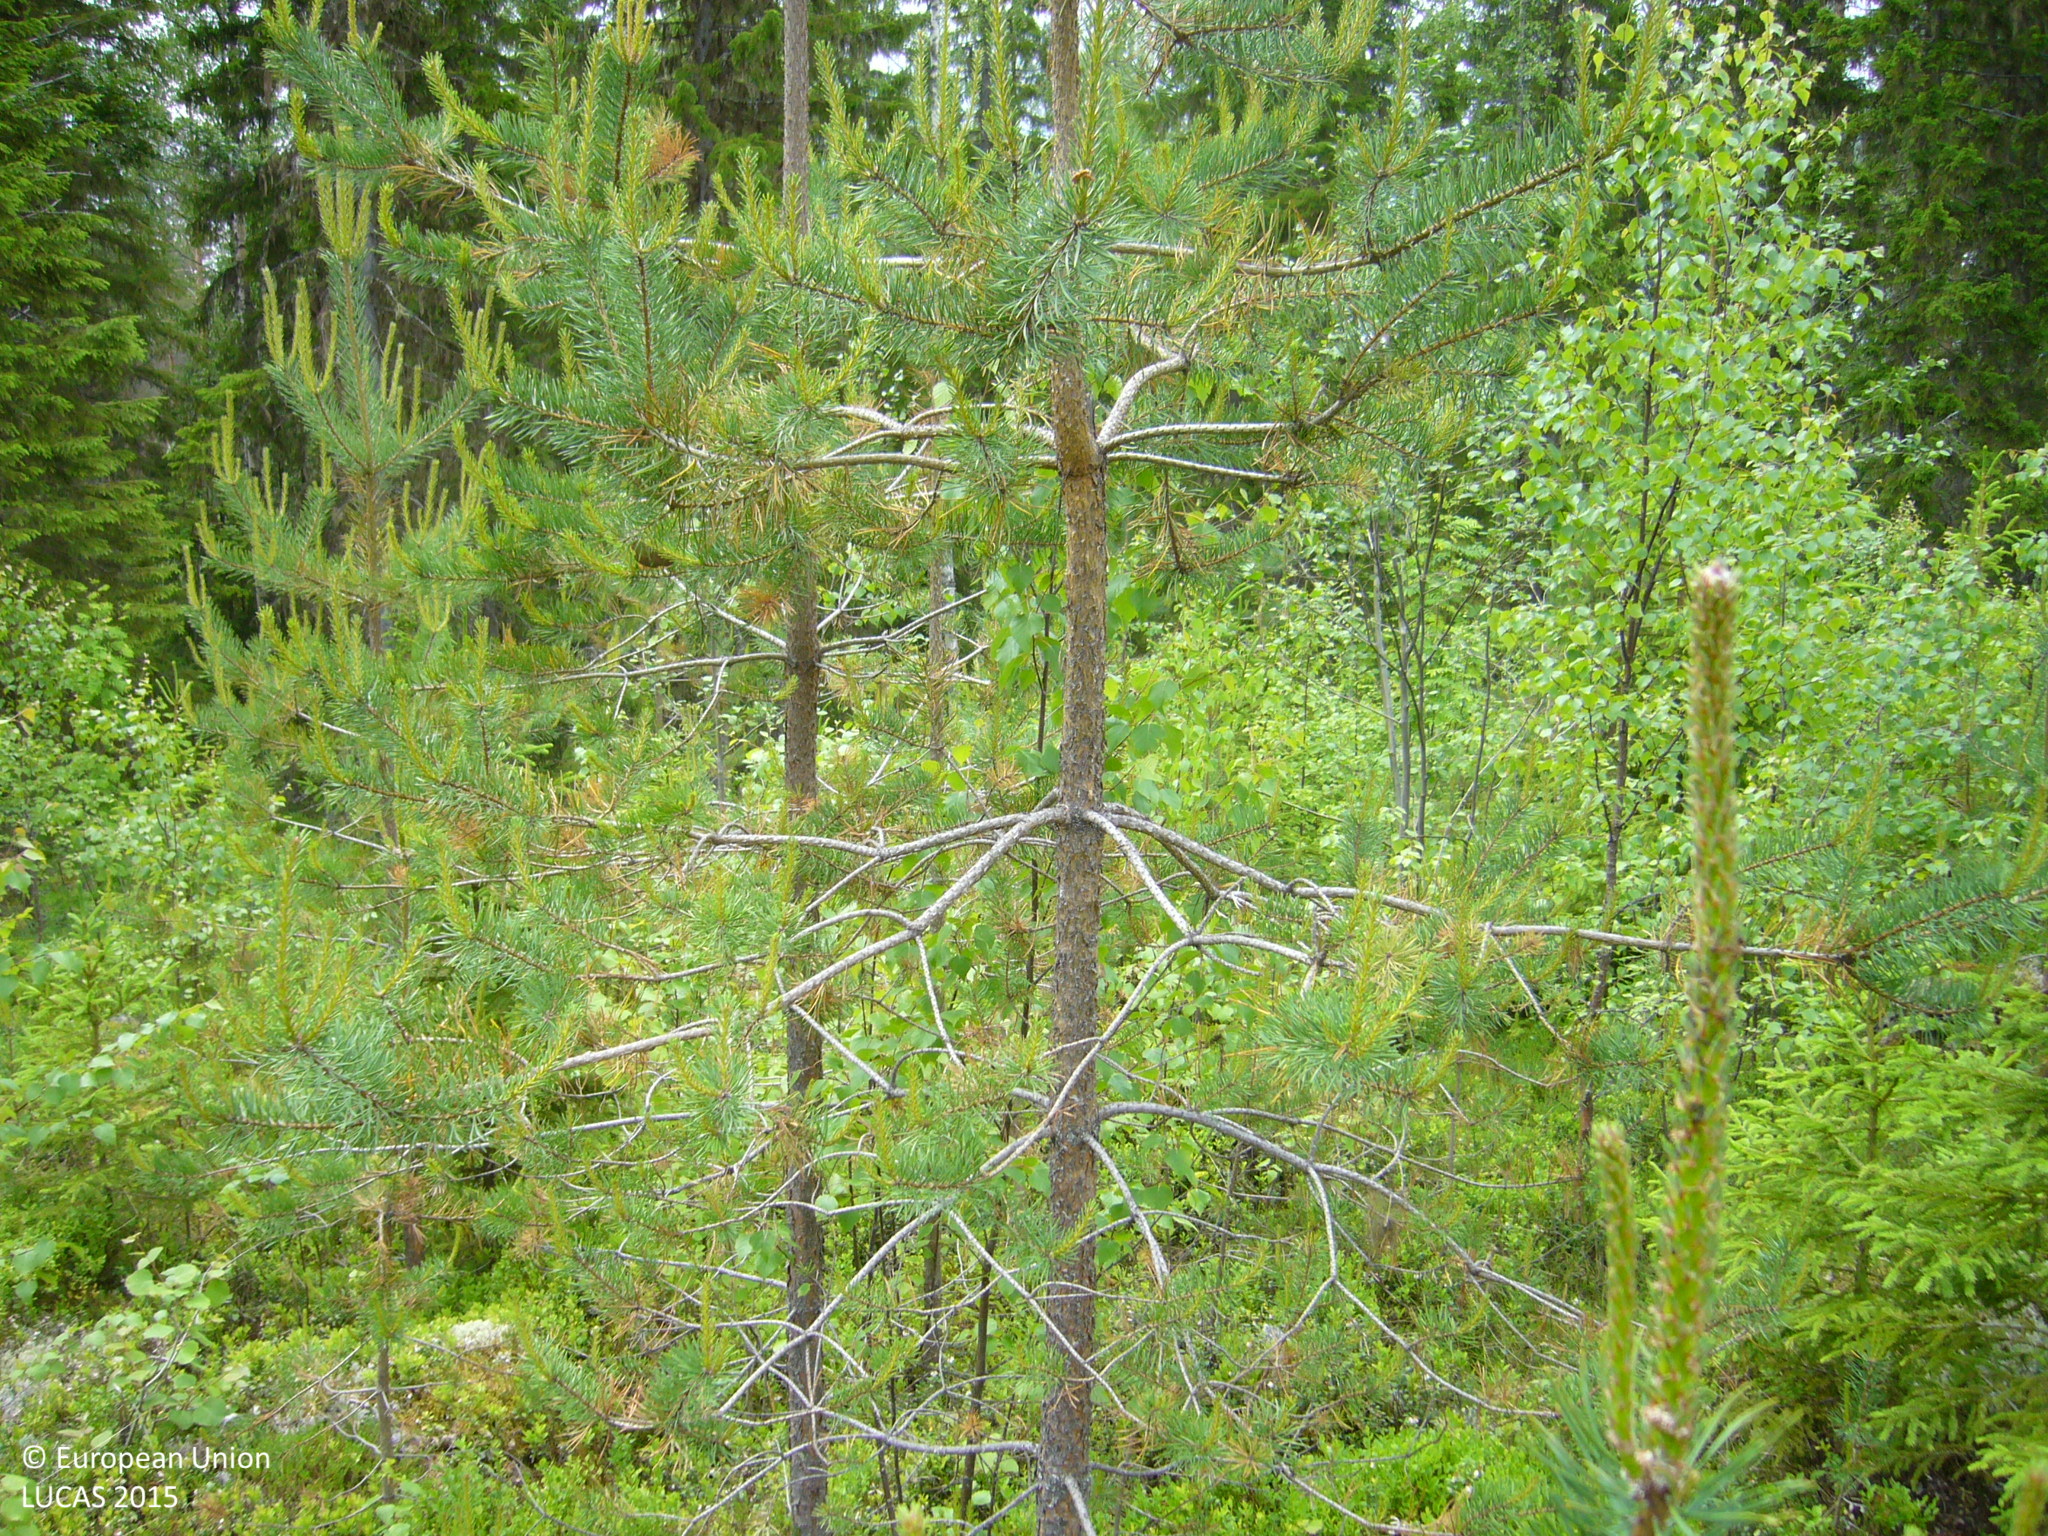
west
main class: Woodland
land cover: Pine dominated coniferous woodland
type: boreal forest
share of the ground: 50 - 75 %
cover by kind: coniferous forest trees 50 %, lichens and mosses 40 %, shrubs 10 %
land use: Forestry
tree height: > 5 m
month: July
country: FI
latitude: 63.4349
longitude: 26.1314
